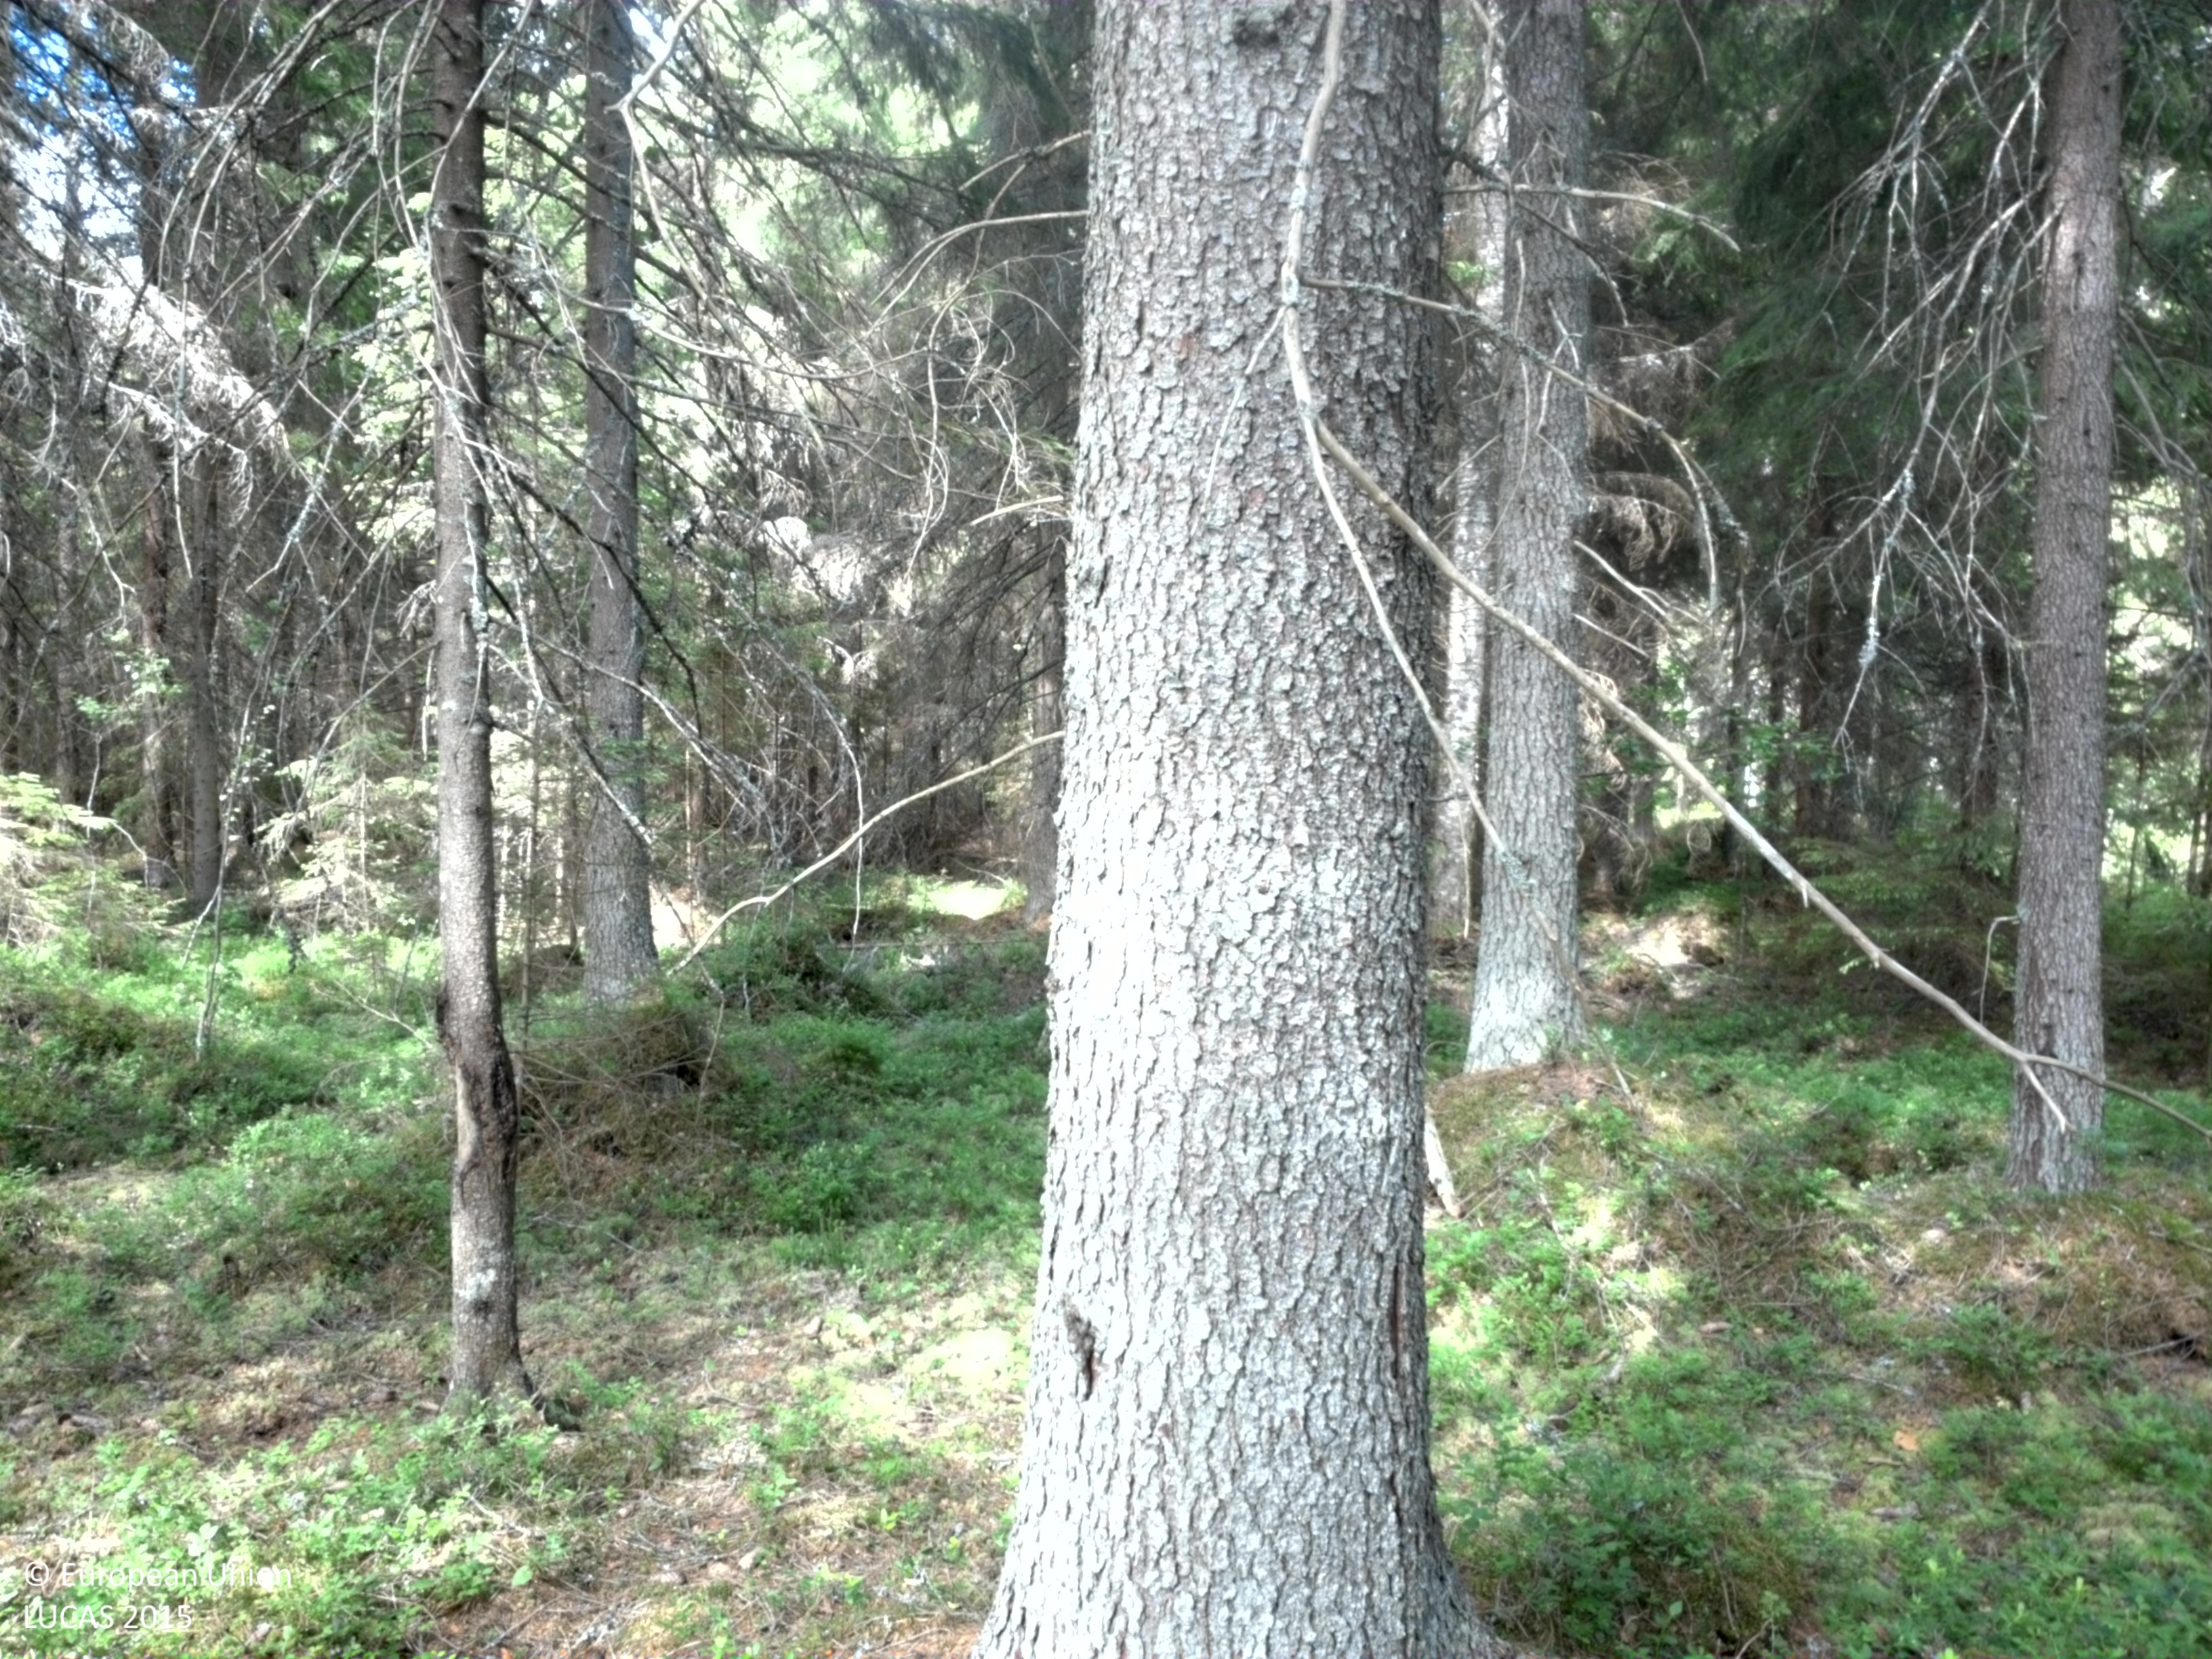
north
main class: Woodland
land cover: Spruce dominated coniferous woodland
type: boreal forest
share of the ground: > 75 %
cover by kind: coniferous forest trees 70 %, herbaceous plants 20 %, broadleaved forest trees 10 %
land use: Forestry
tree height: > 5 m
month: July
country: SE
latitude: 60.0228
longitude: 17.0431
